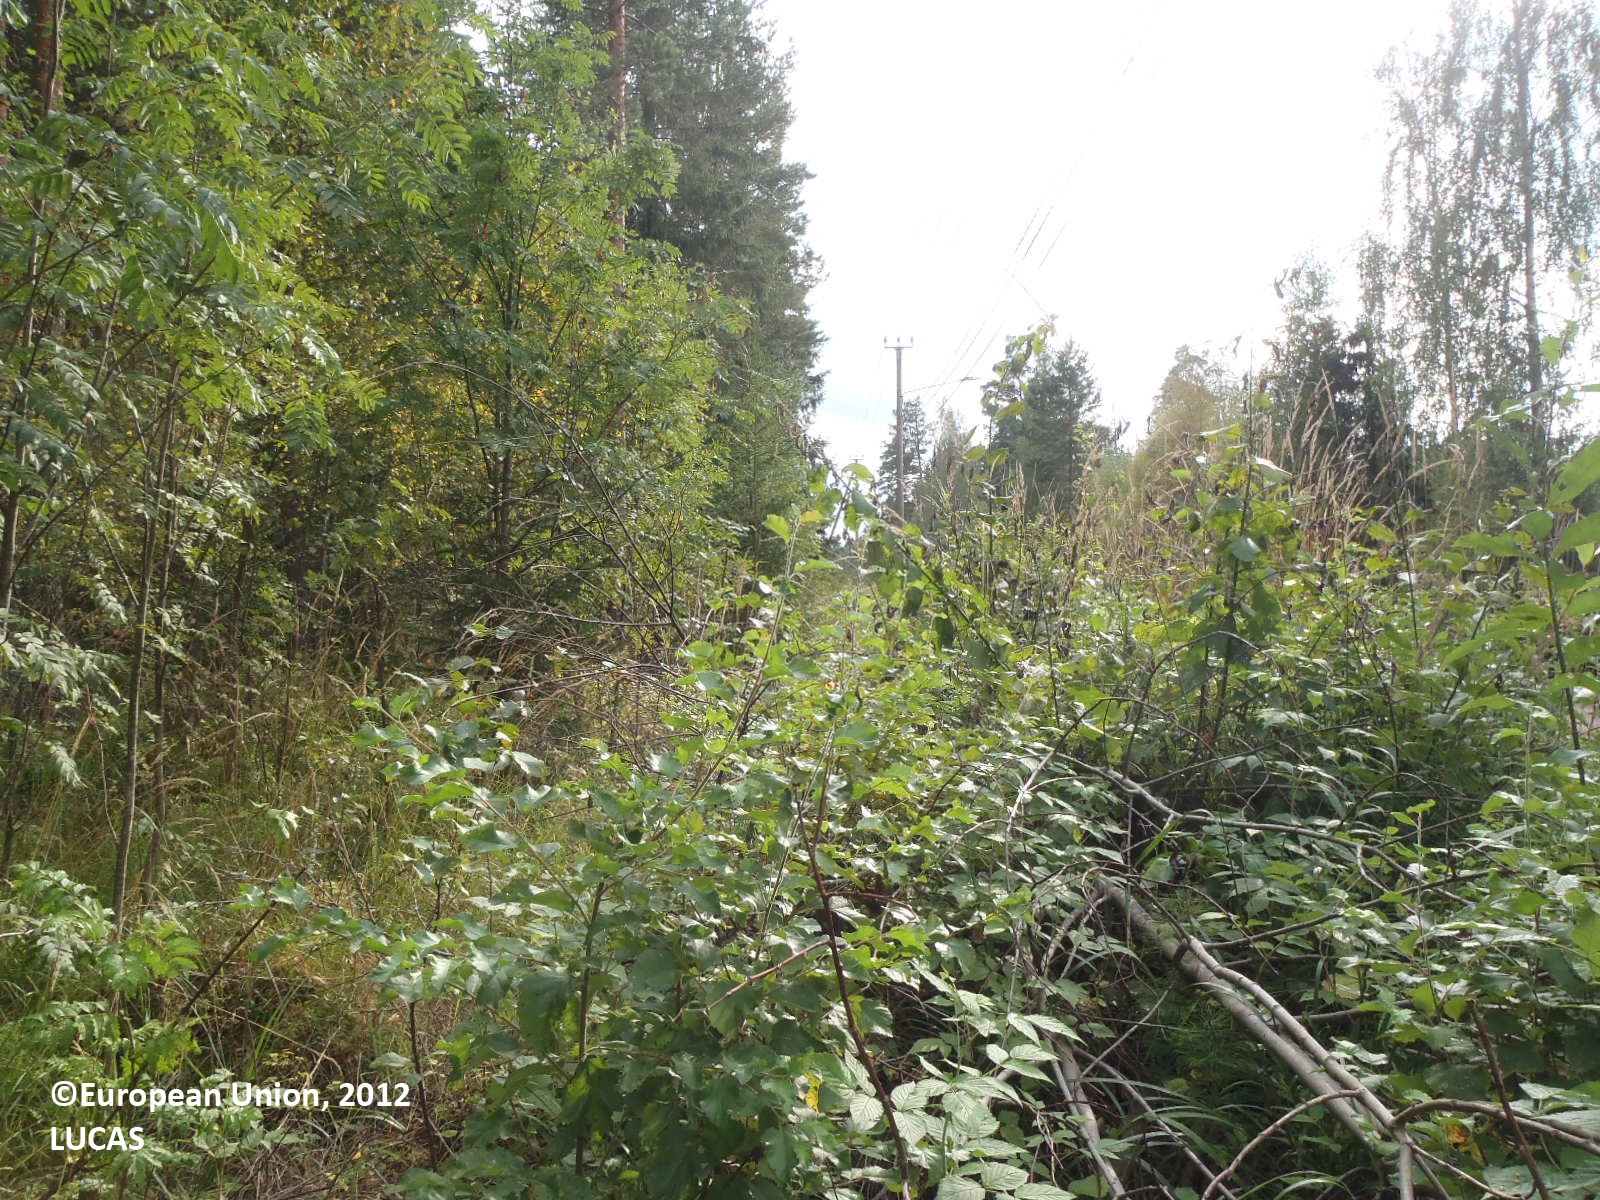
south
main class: Woodland
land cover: Broadleaved woodland
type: boreal forest
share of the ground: > 75 %
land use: Forestry
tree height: > 5 m
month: August
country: FI
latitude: 60.9736
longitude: 22.5011
